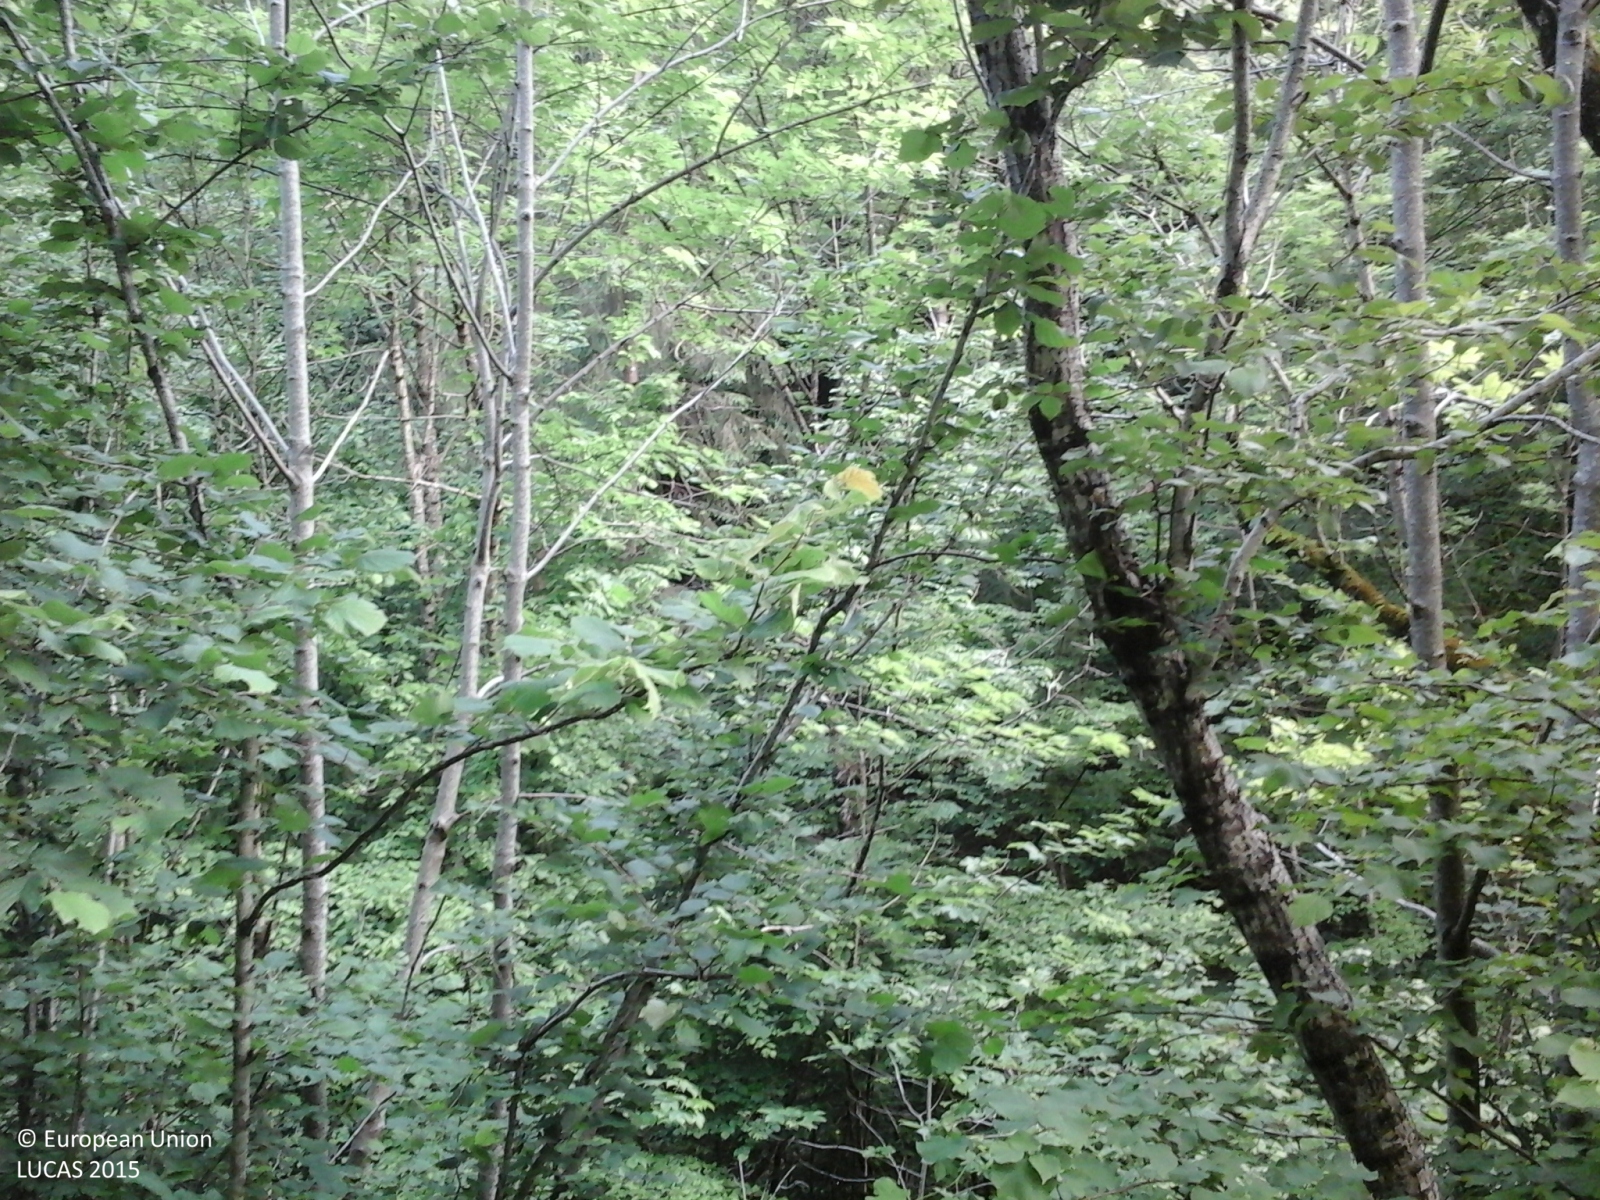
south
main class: Woodland
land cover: Broadleaved woodland
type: thermophilous deciduous forest
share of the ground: > 75 %
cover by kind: broadleaved forest trees 80 %, coniferous forest trees 20 %
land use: Semi-natural and natural areas not in use
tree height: > 5 m
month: June
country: IT
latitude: 45.8102
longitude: 10.3469
